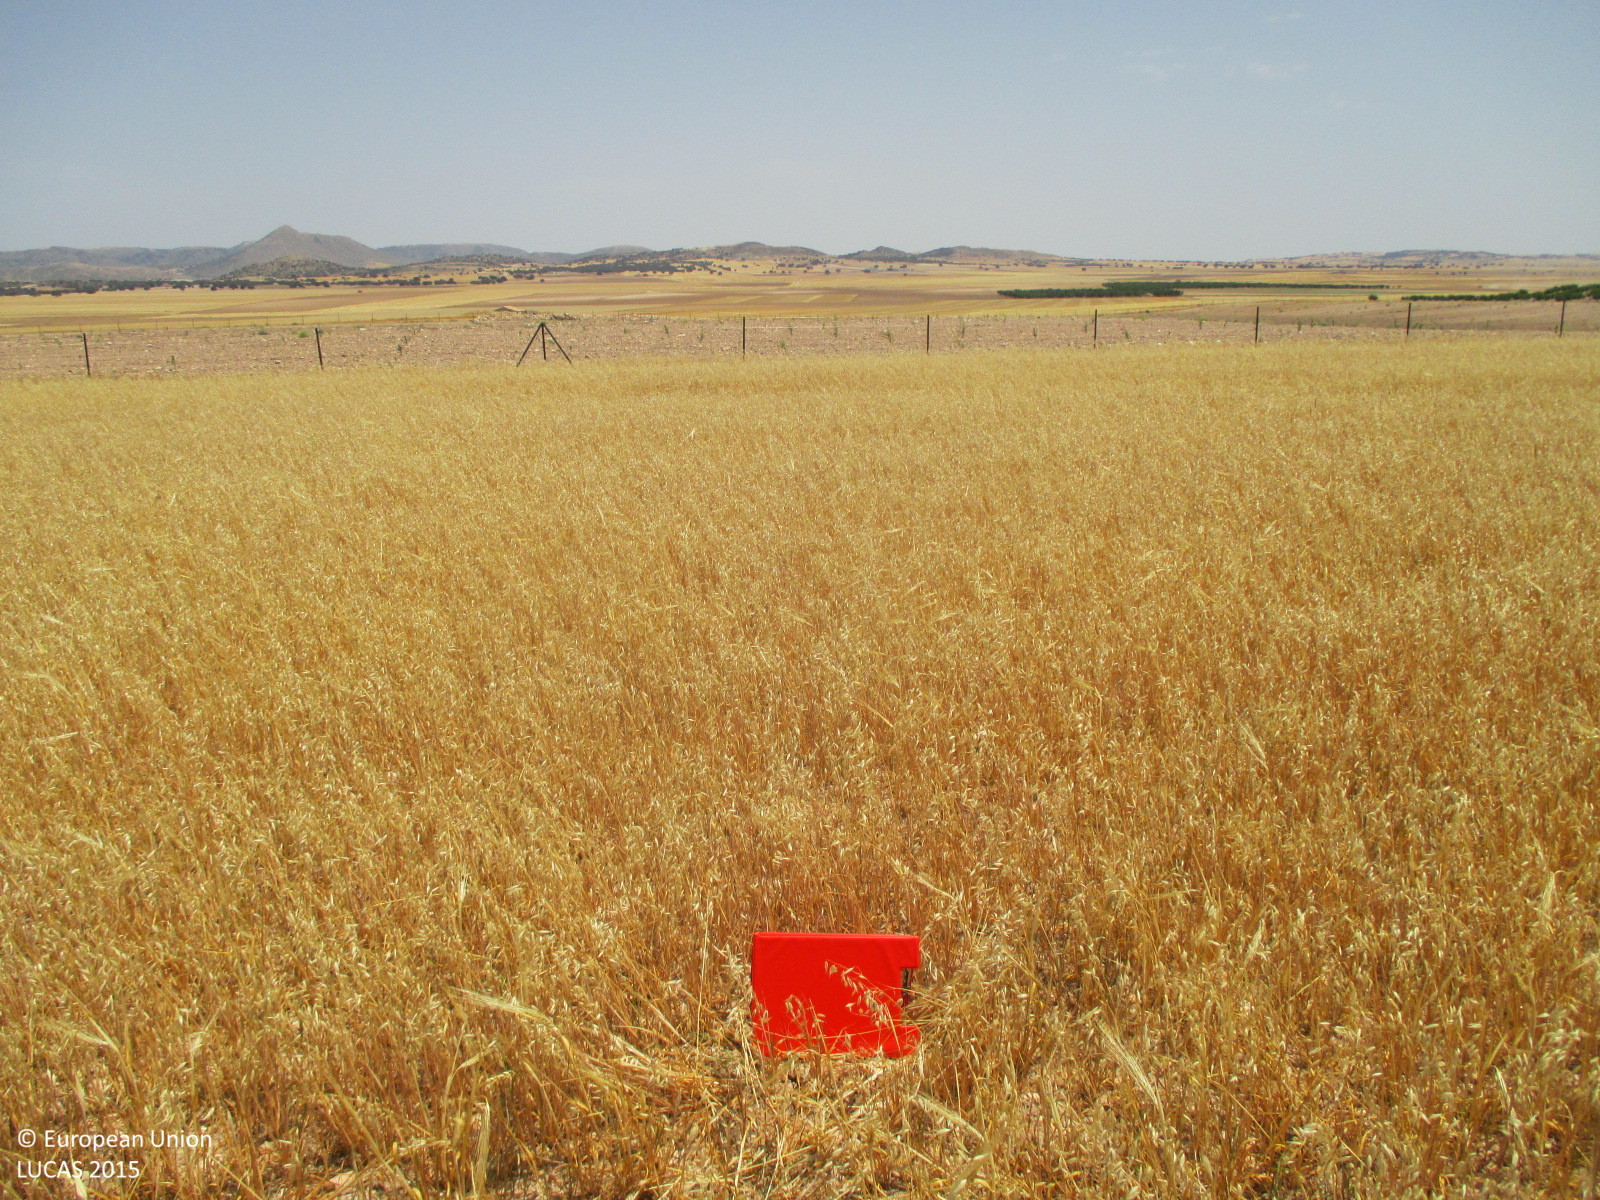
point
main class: Cropland
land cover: Oats
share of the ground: > 75 %
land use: Agriculture (excluding fallow land and kitchen gardens)
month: July
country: ES
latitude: 37.8261
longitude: -2.2925
